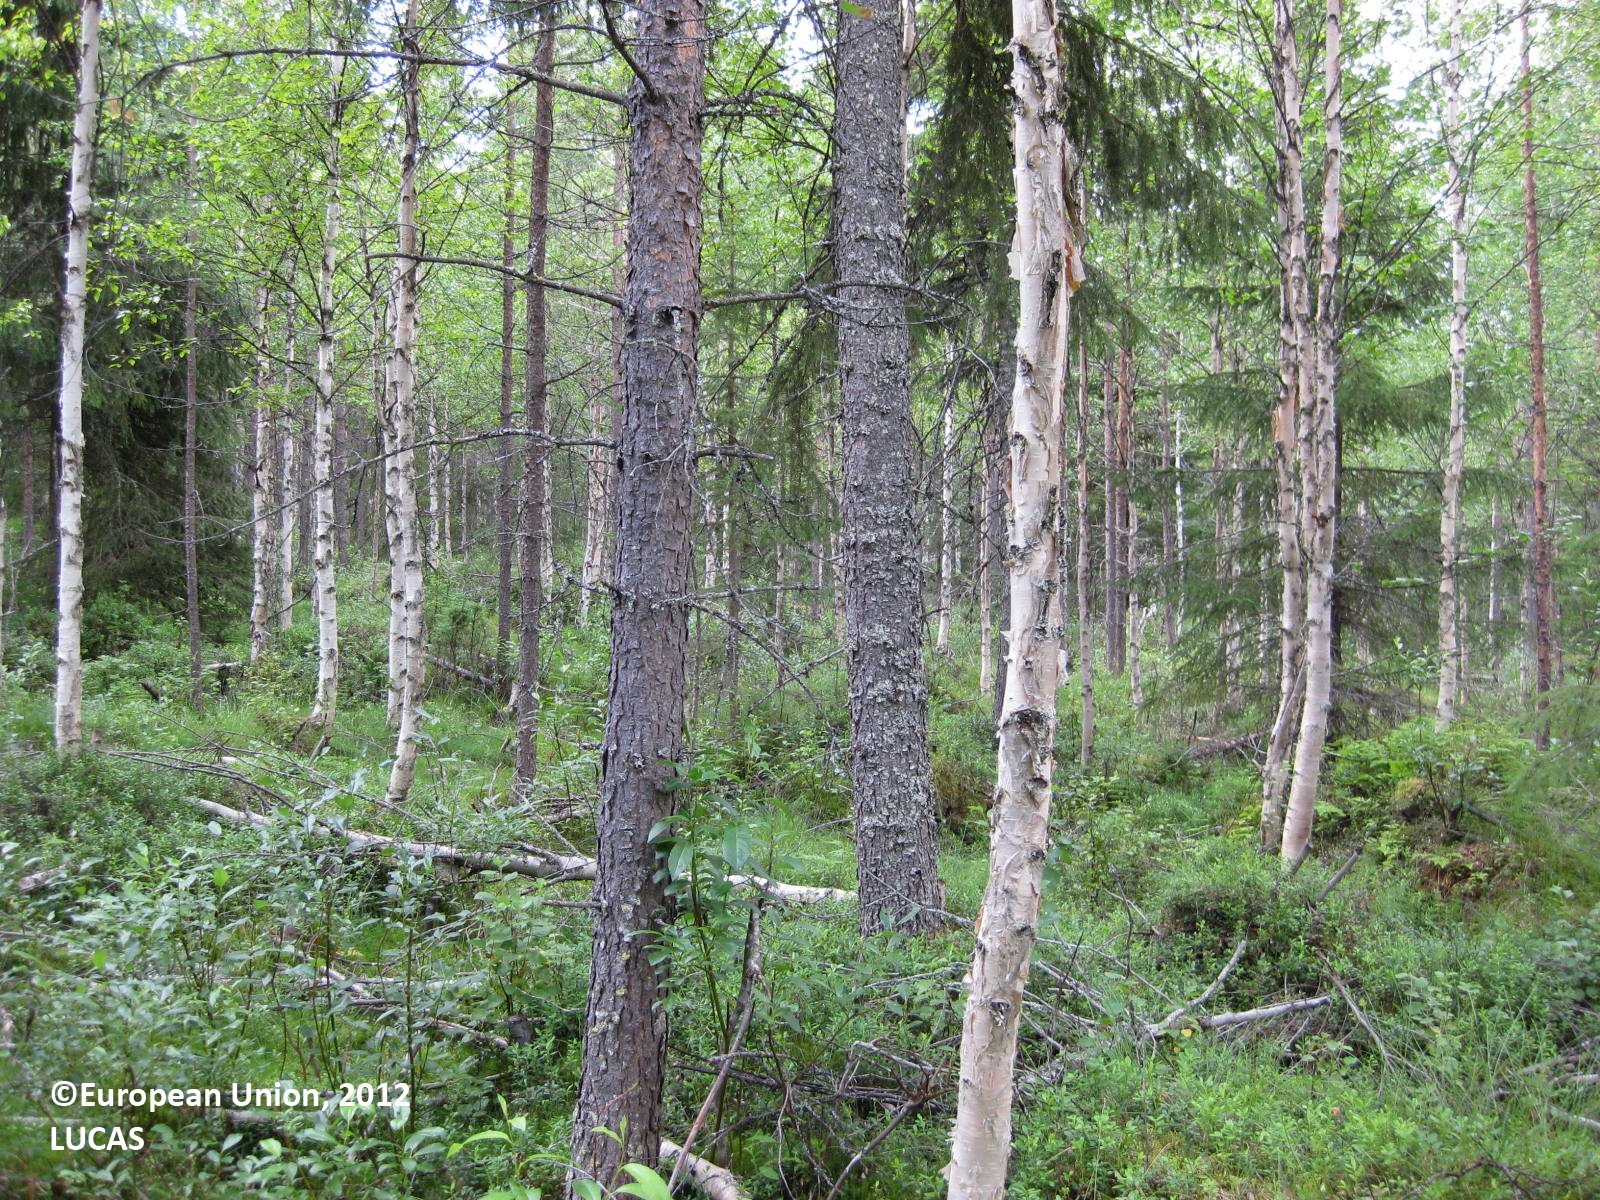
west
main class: Woodland
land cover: Other mixed woodland
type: boreal forest
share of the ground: > 75 %
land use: Forestry
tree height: > 5 m
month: July
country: FI
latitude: 65.6861
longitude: 28.5079
